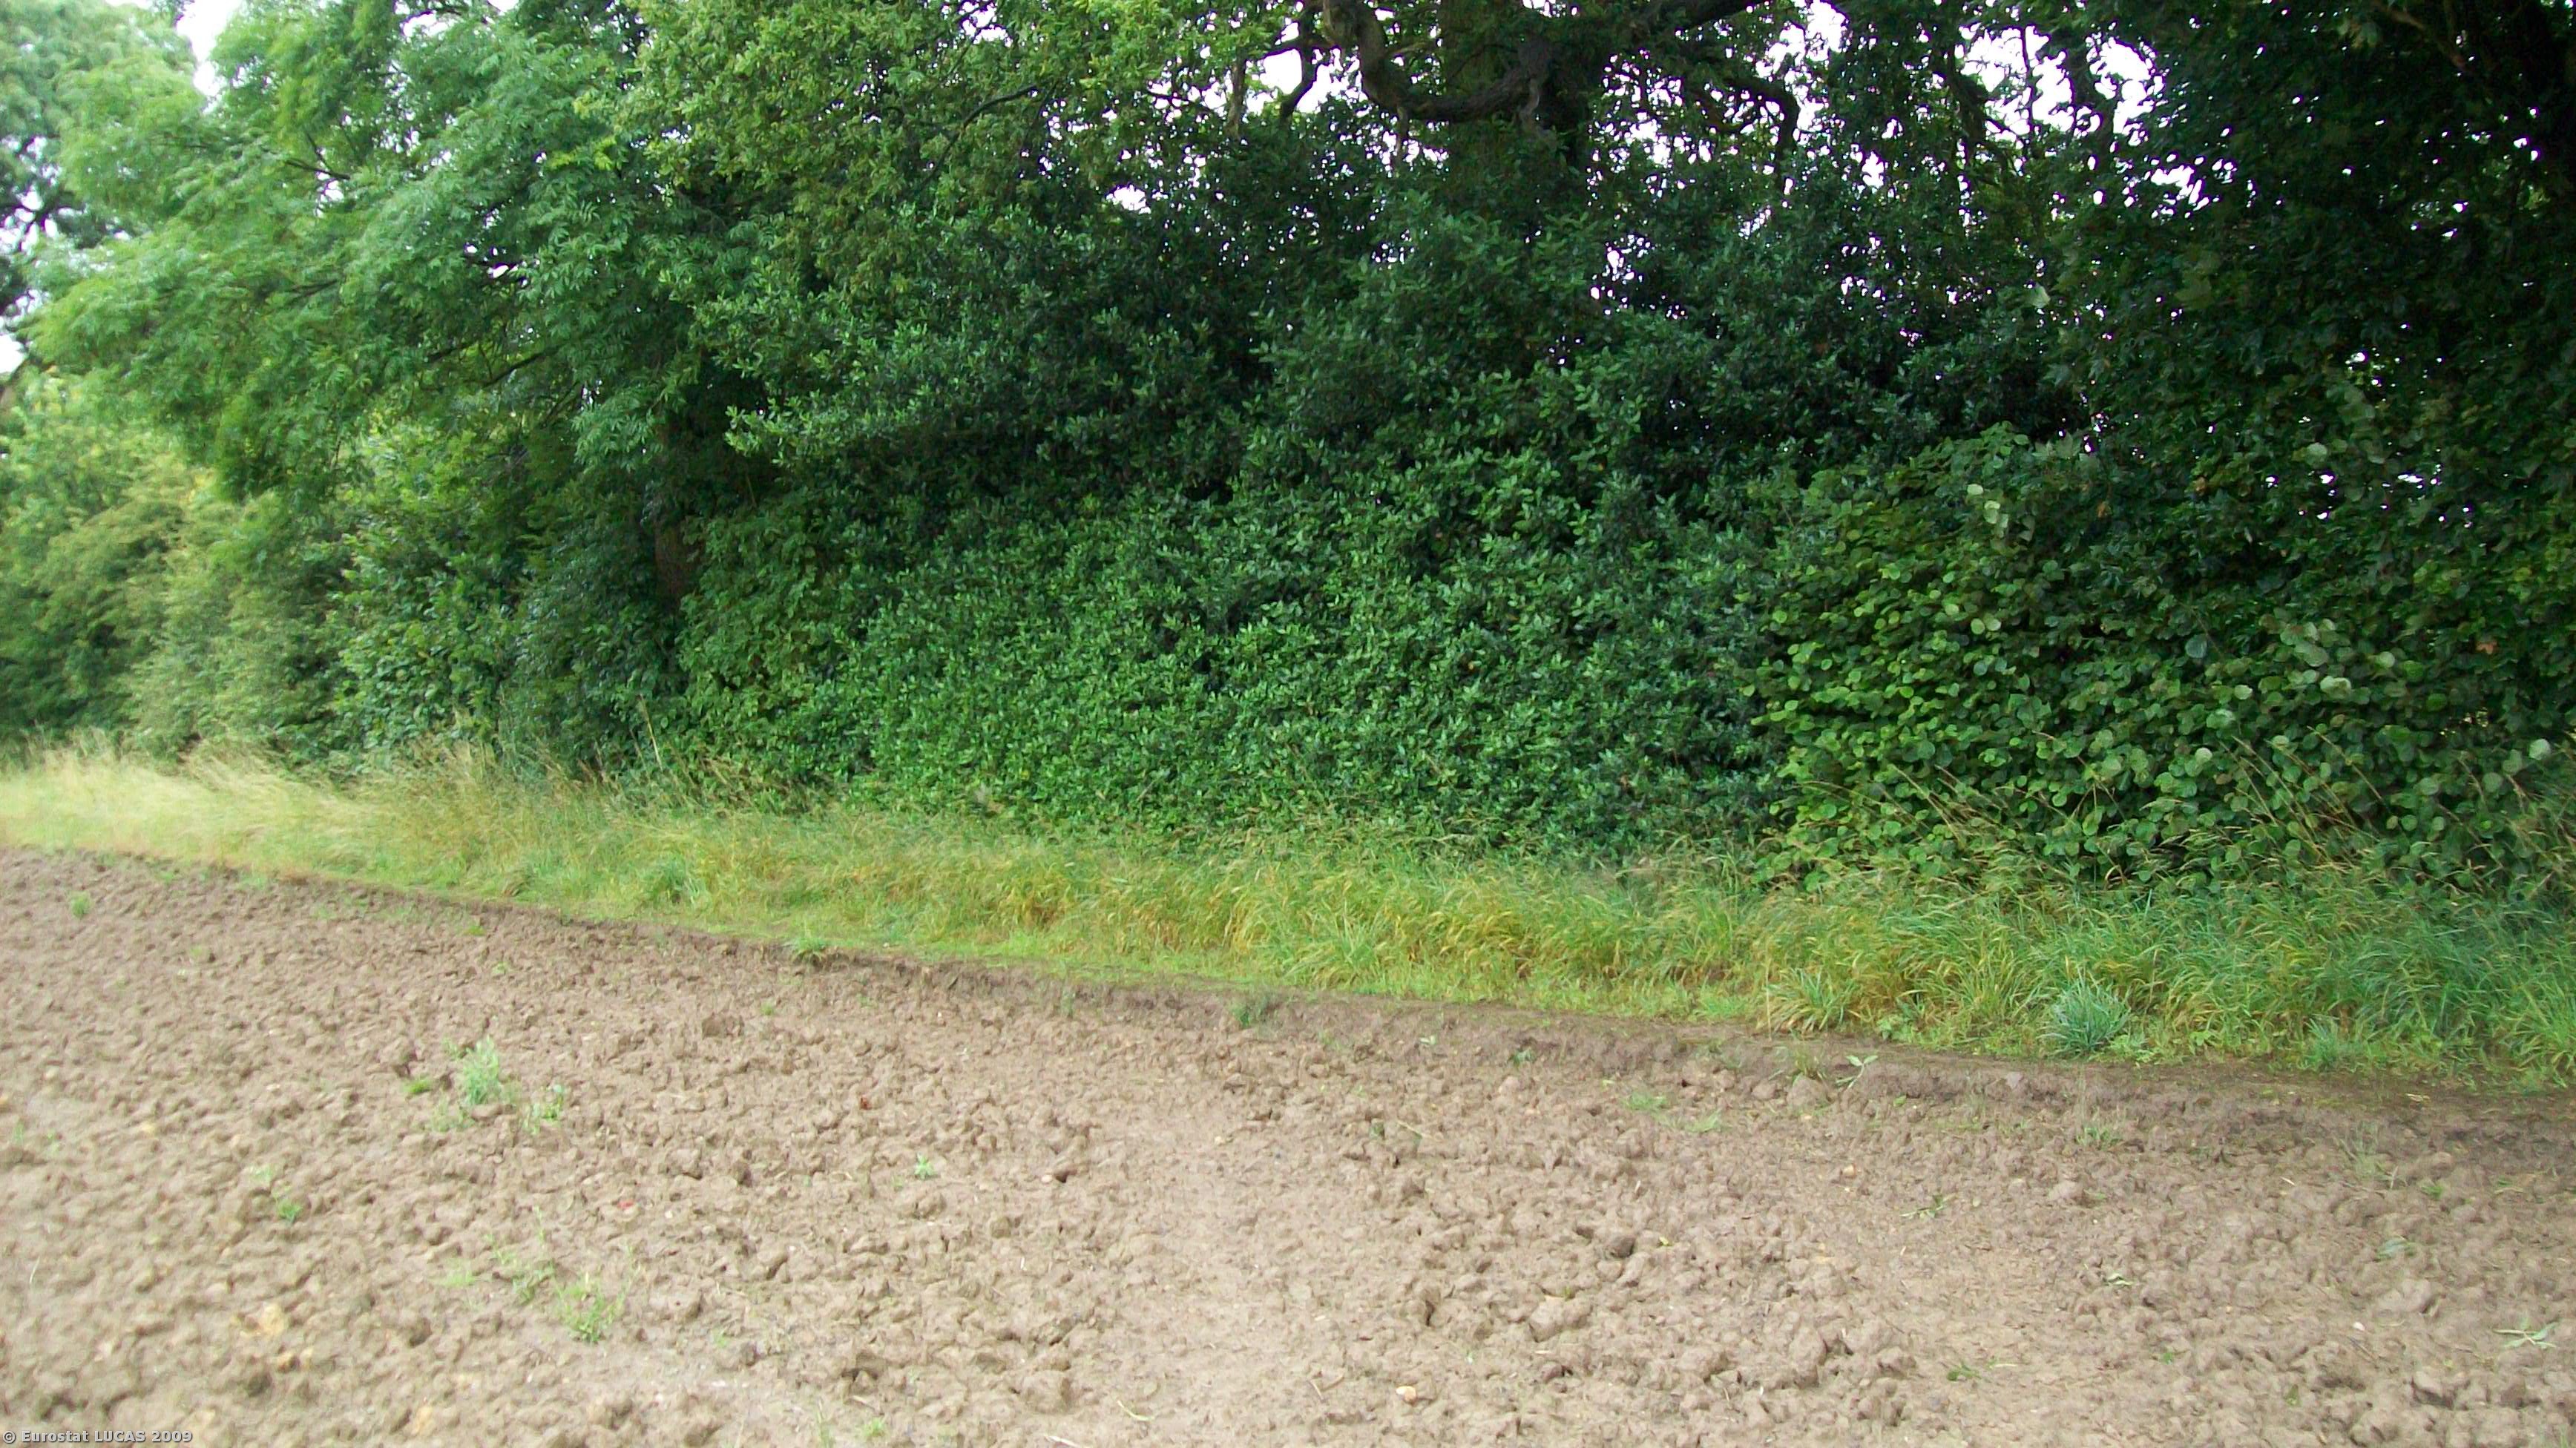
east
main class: Cropland
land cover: Common wheat
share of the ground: > 75 %
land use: Agriculture (excluding fallow land and kitchen gardens)
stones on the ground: 10 - 25 %
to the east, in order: Common wheat; Grass margins; Abandoned hedges; Grass margins; Common wheat; Grass margins; Abandoned hedges; Grassland with sparse tree/shrub cover
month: July
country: GB
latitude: 52.7662
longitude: -1.4470
